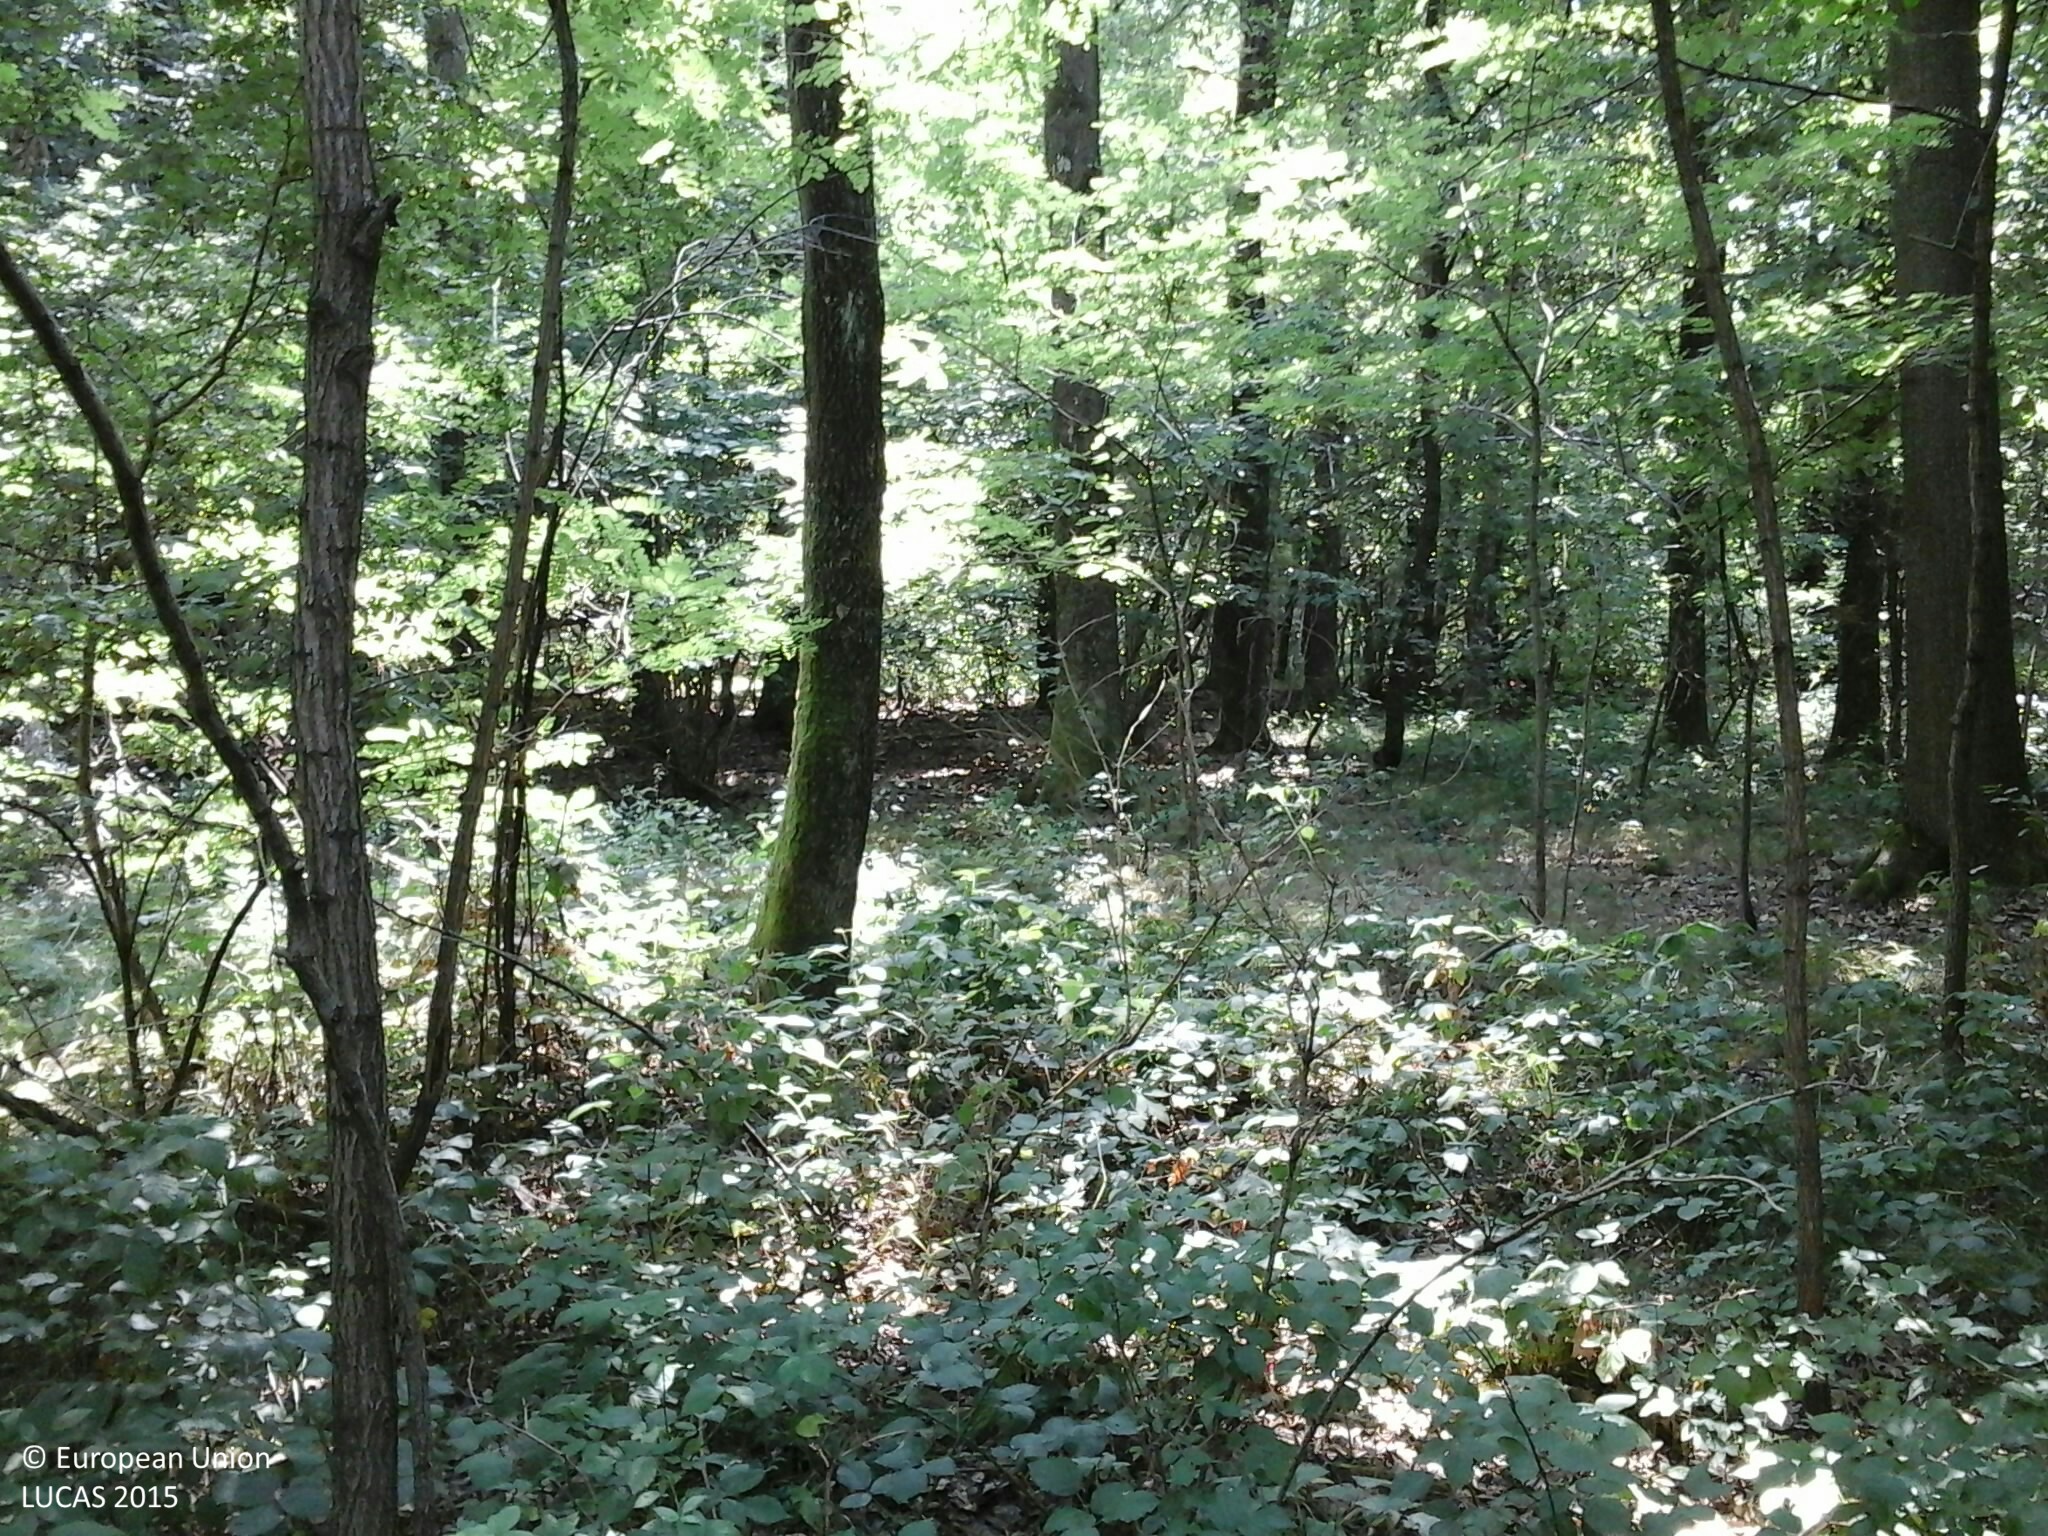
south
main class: Woodland
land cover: Broadleaved woodland
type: beech forest
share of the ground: > 75 %
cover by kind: broadleaved forest trees 65 %, shrubs 20 %, herbaceous plants 15 %
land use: Forestry
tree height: > 5 m
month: July
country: HU
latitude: 46.6384
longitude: 16.5464
